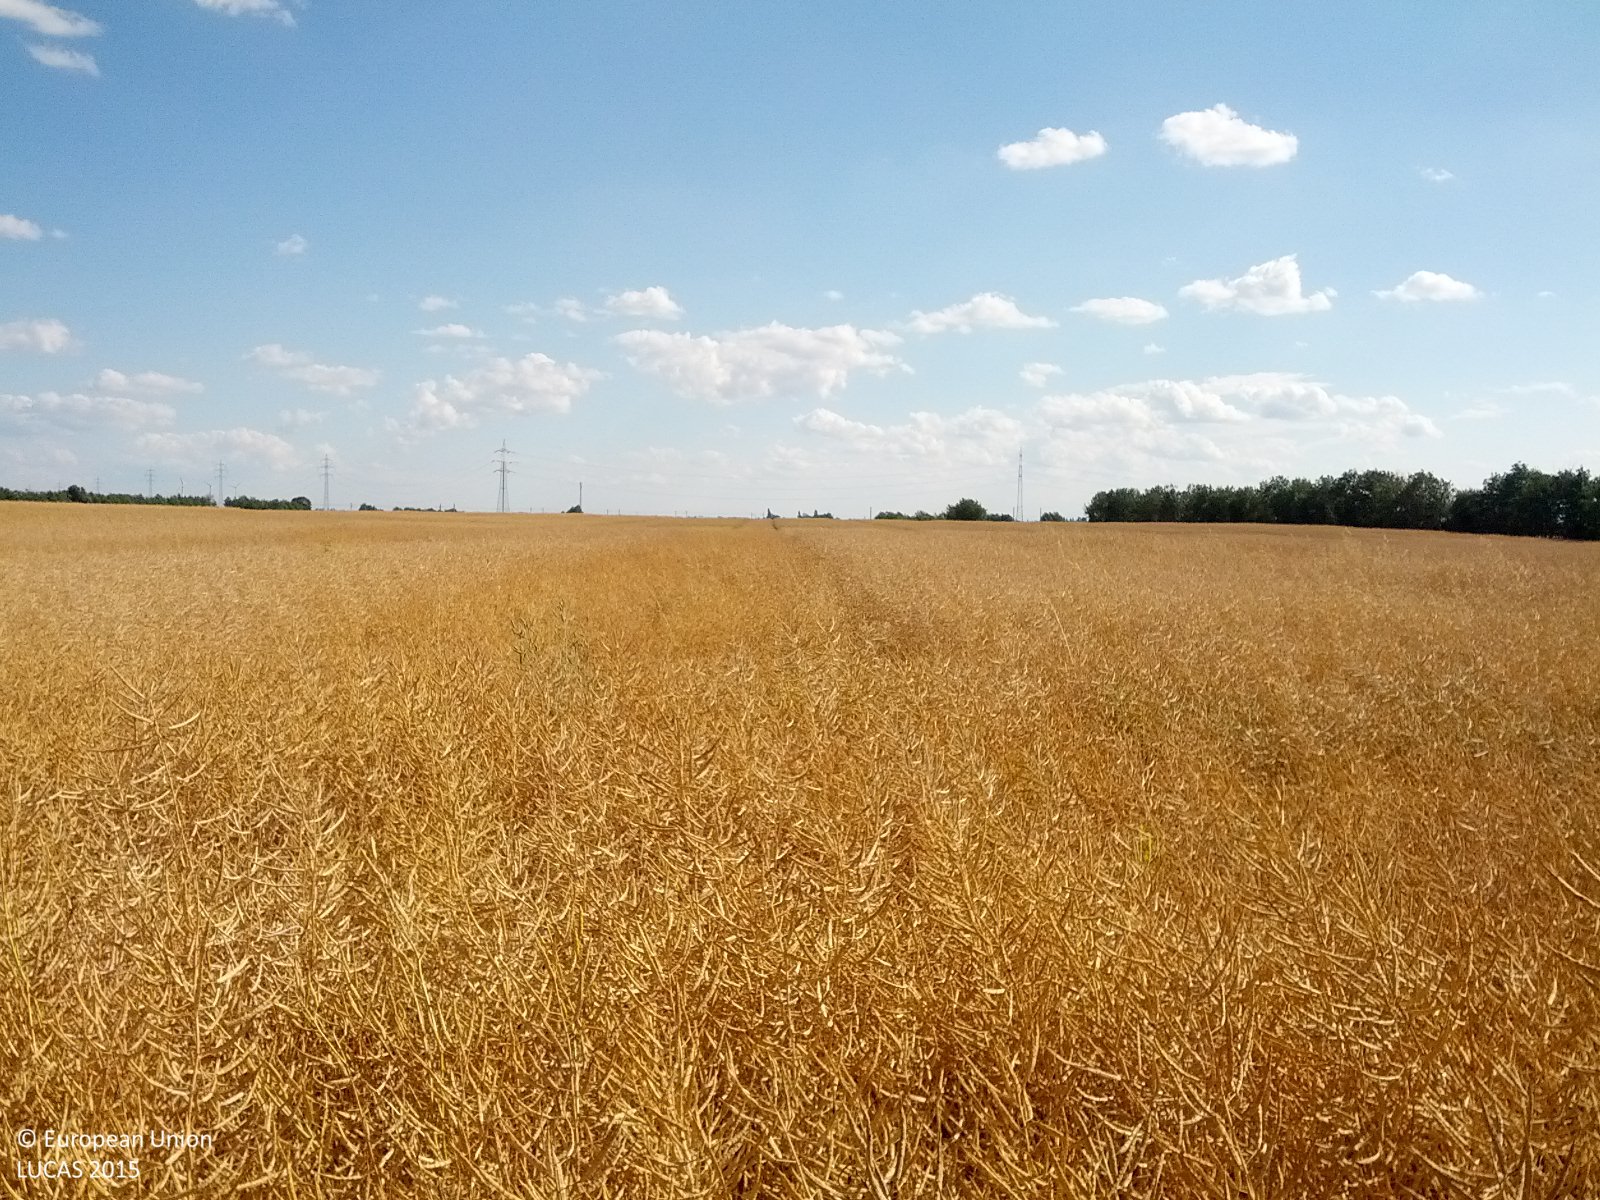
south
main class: Cropland
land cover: Rape and turnip rape
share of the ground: > 75 %
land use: Agriculture (excluding fallow land and kitchen gardens)
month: June
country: AT
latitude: 48.3015
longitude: 16.5171
